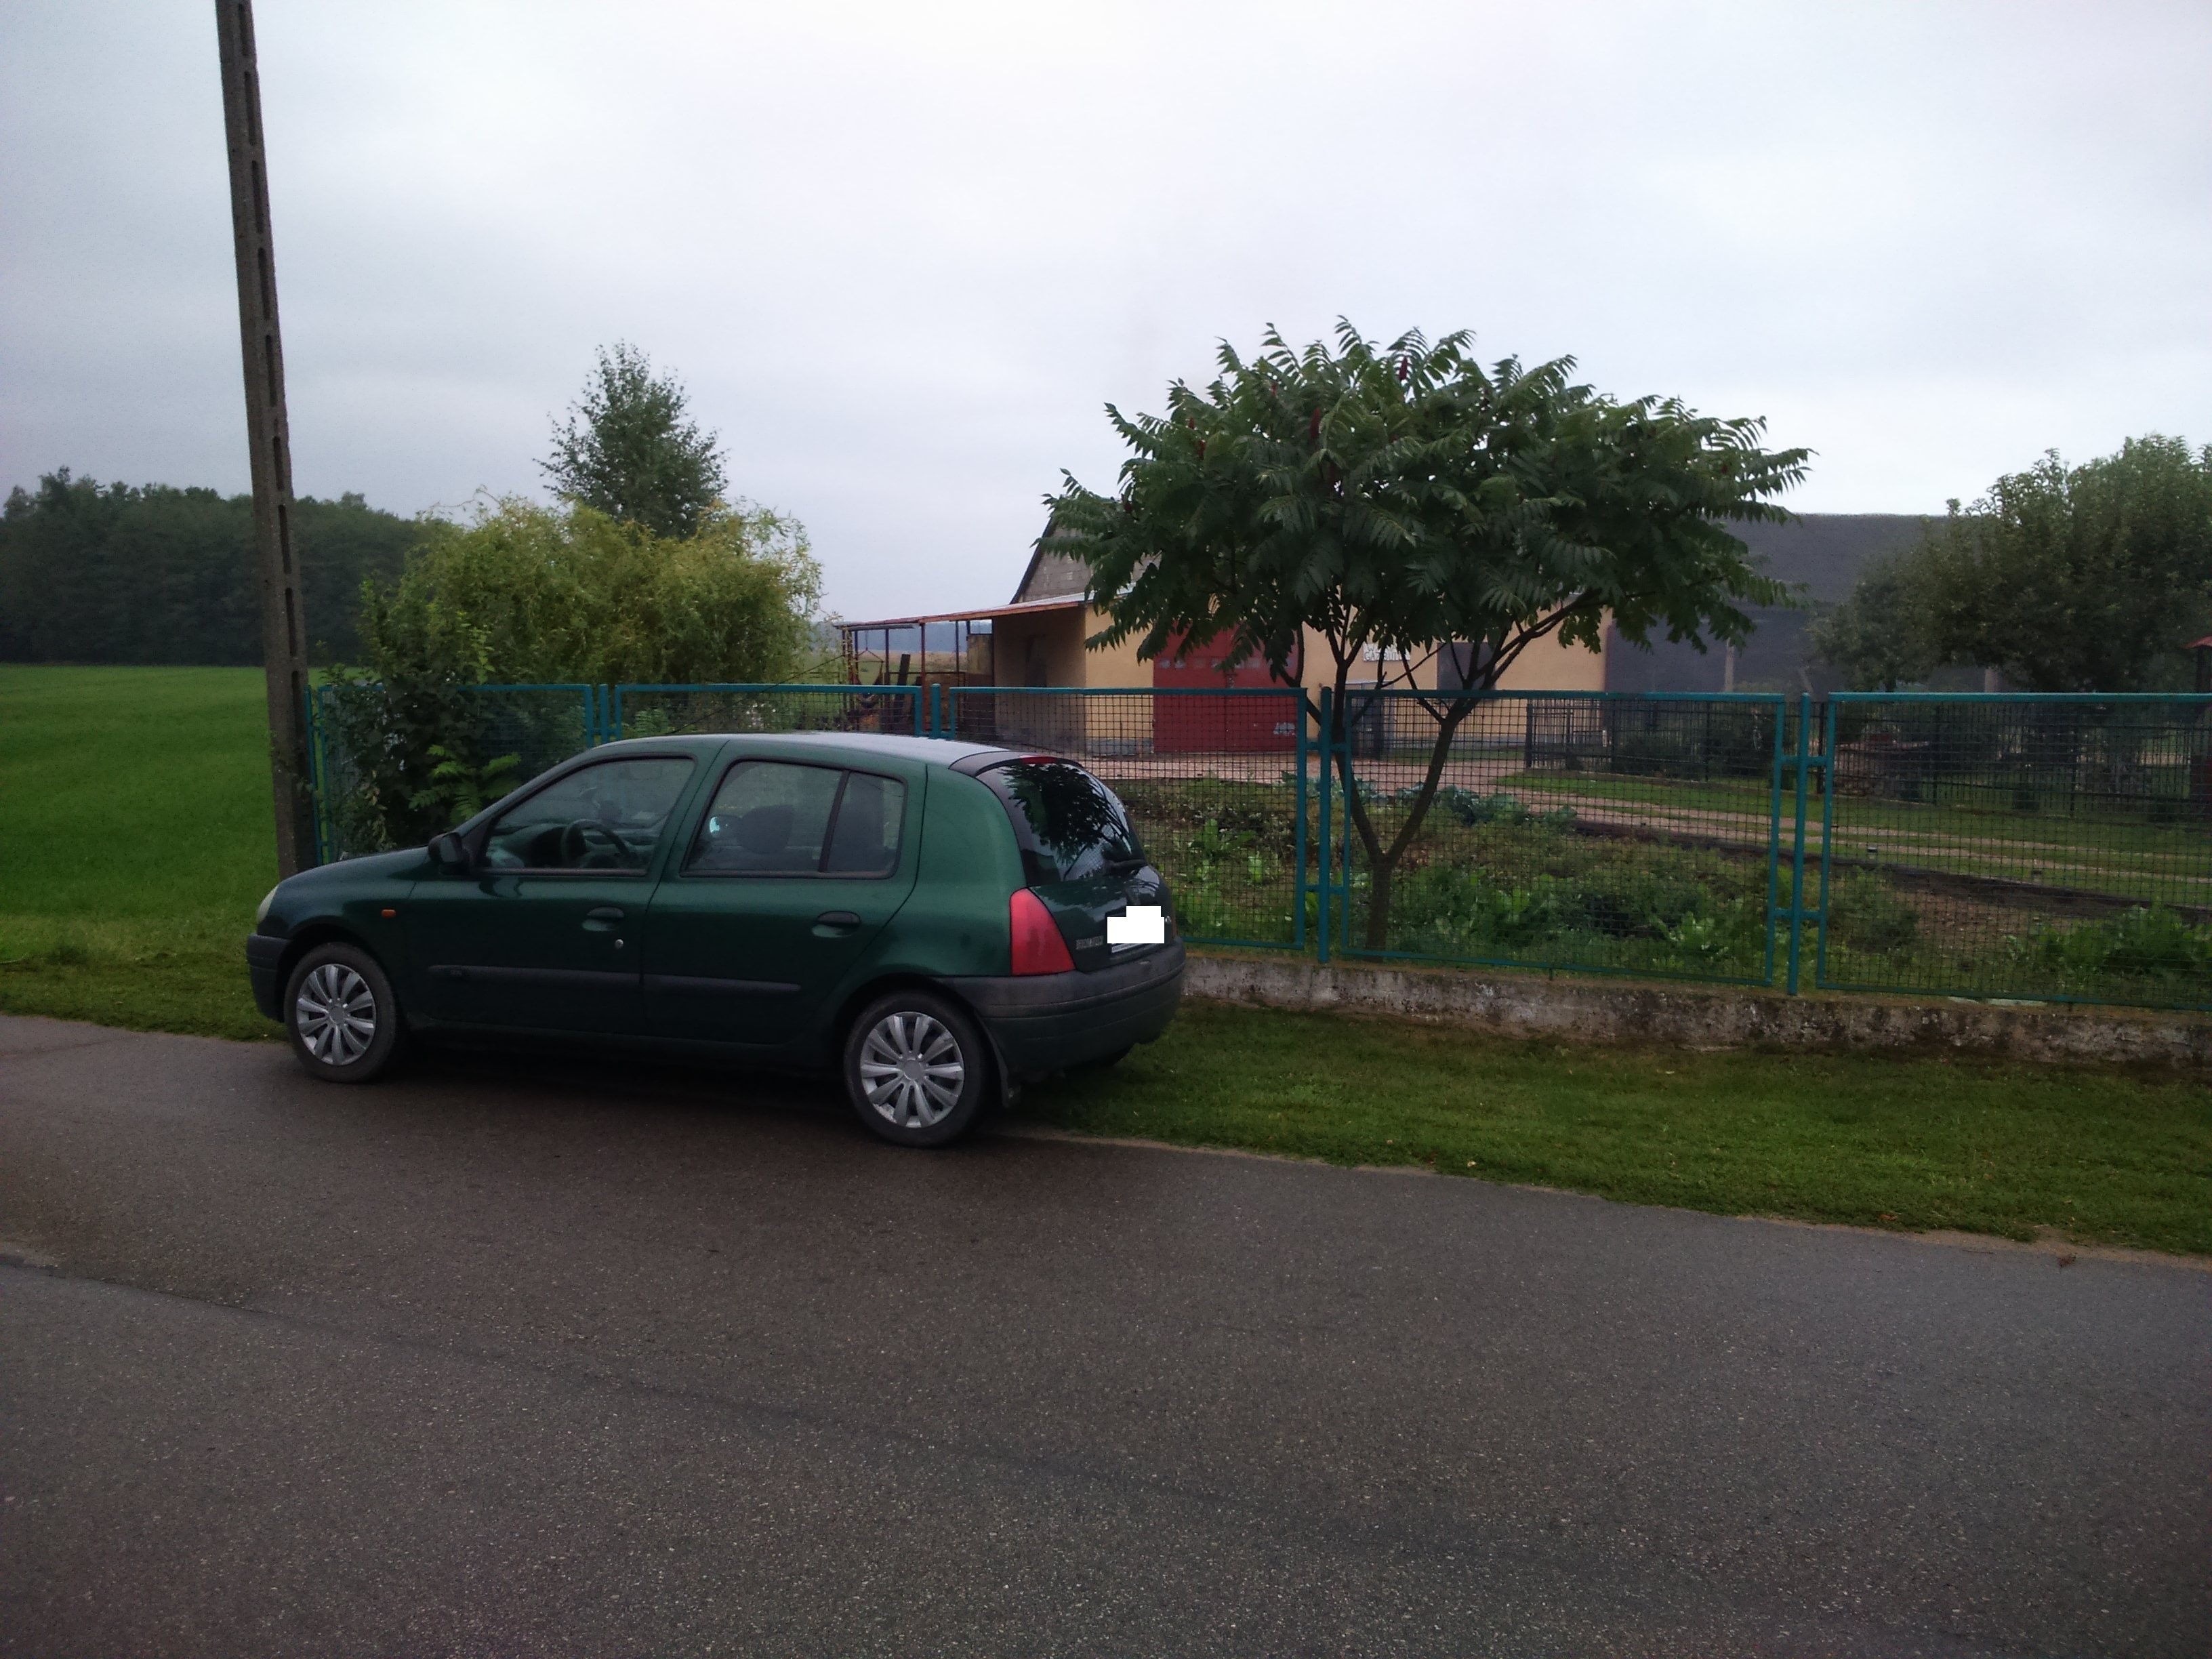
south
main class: Grassland
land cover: Grassland with sparse tree/shrub cover
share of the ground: > 75 %
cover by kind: herbaceous plants 90 %, broadleaved forest trees 5 %, shrubs 5 %
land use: Road transport
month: September
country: PL
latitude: 52.3809
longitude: 22.2111
